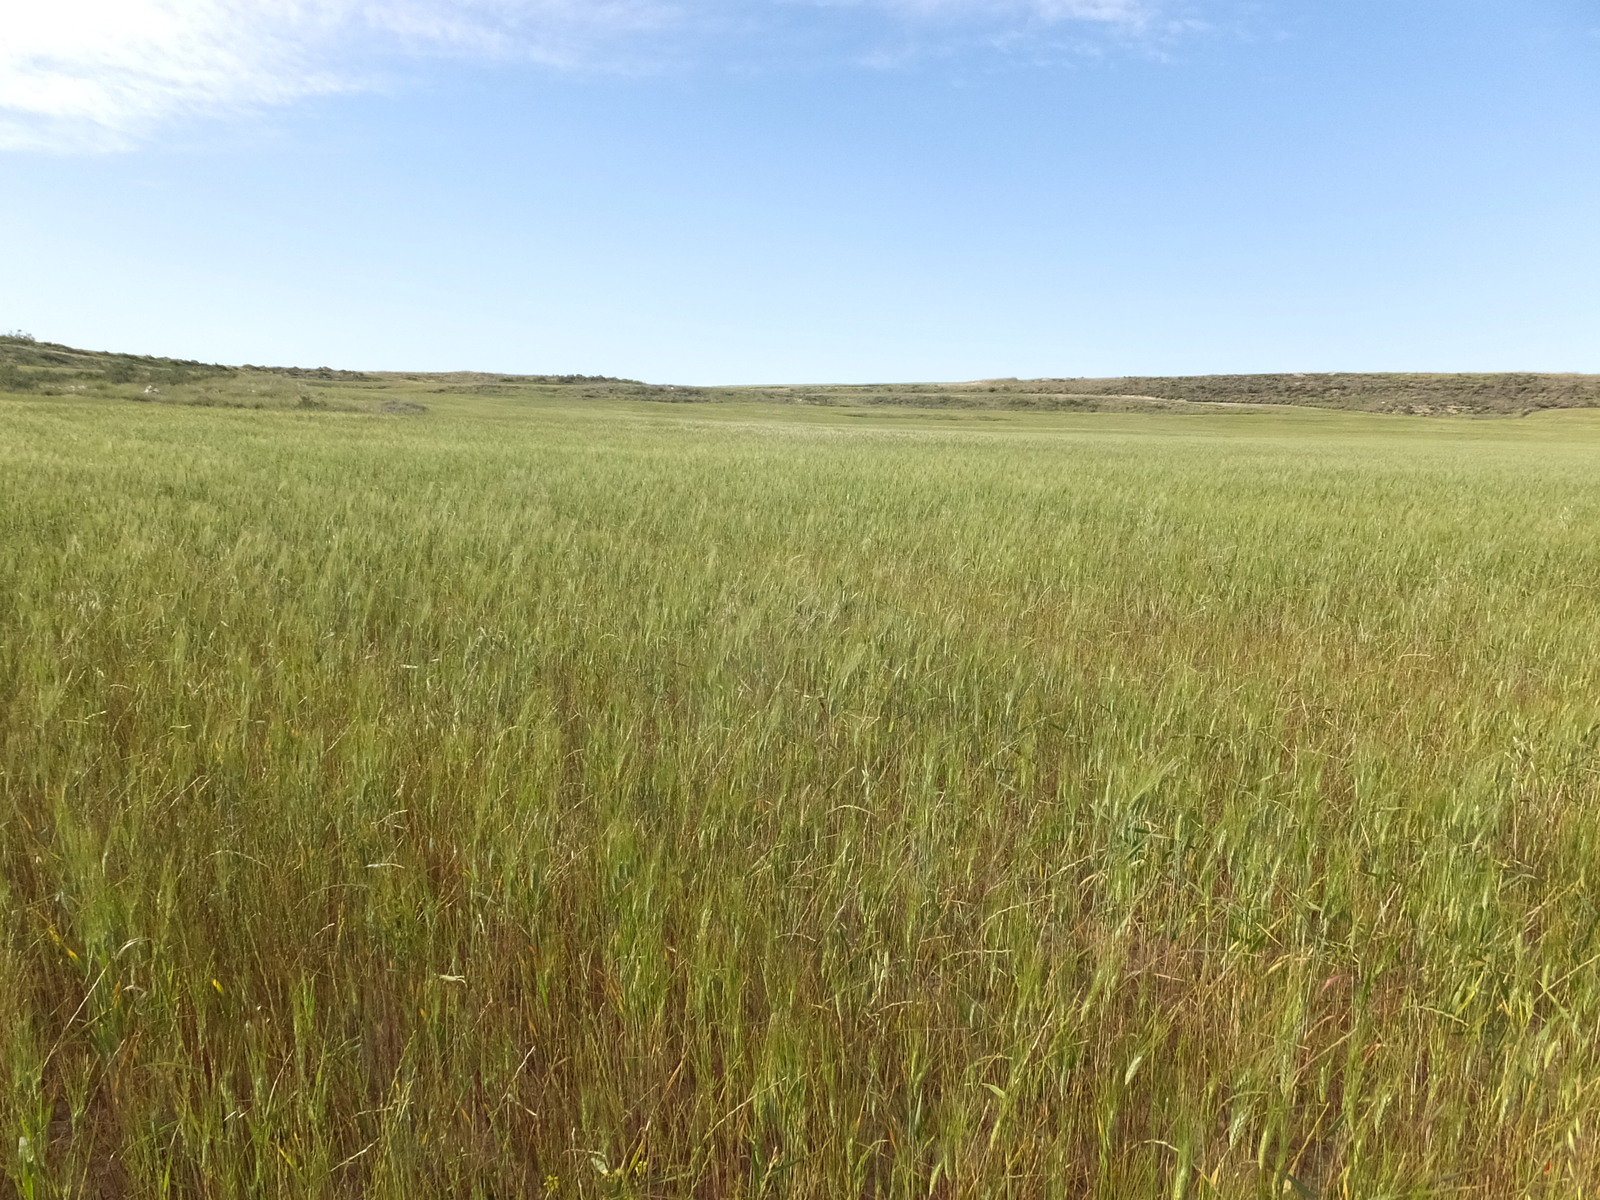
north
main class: Cropland
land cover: Durum wheat
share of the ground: > 75 %
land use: Agriculture (excluding fallow land and kitchen gardens)
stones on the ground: < 10 %
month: May
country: ES
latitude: 41.3698
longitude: -0.2368
